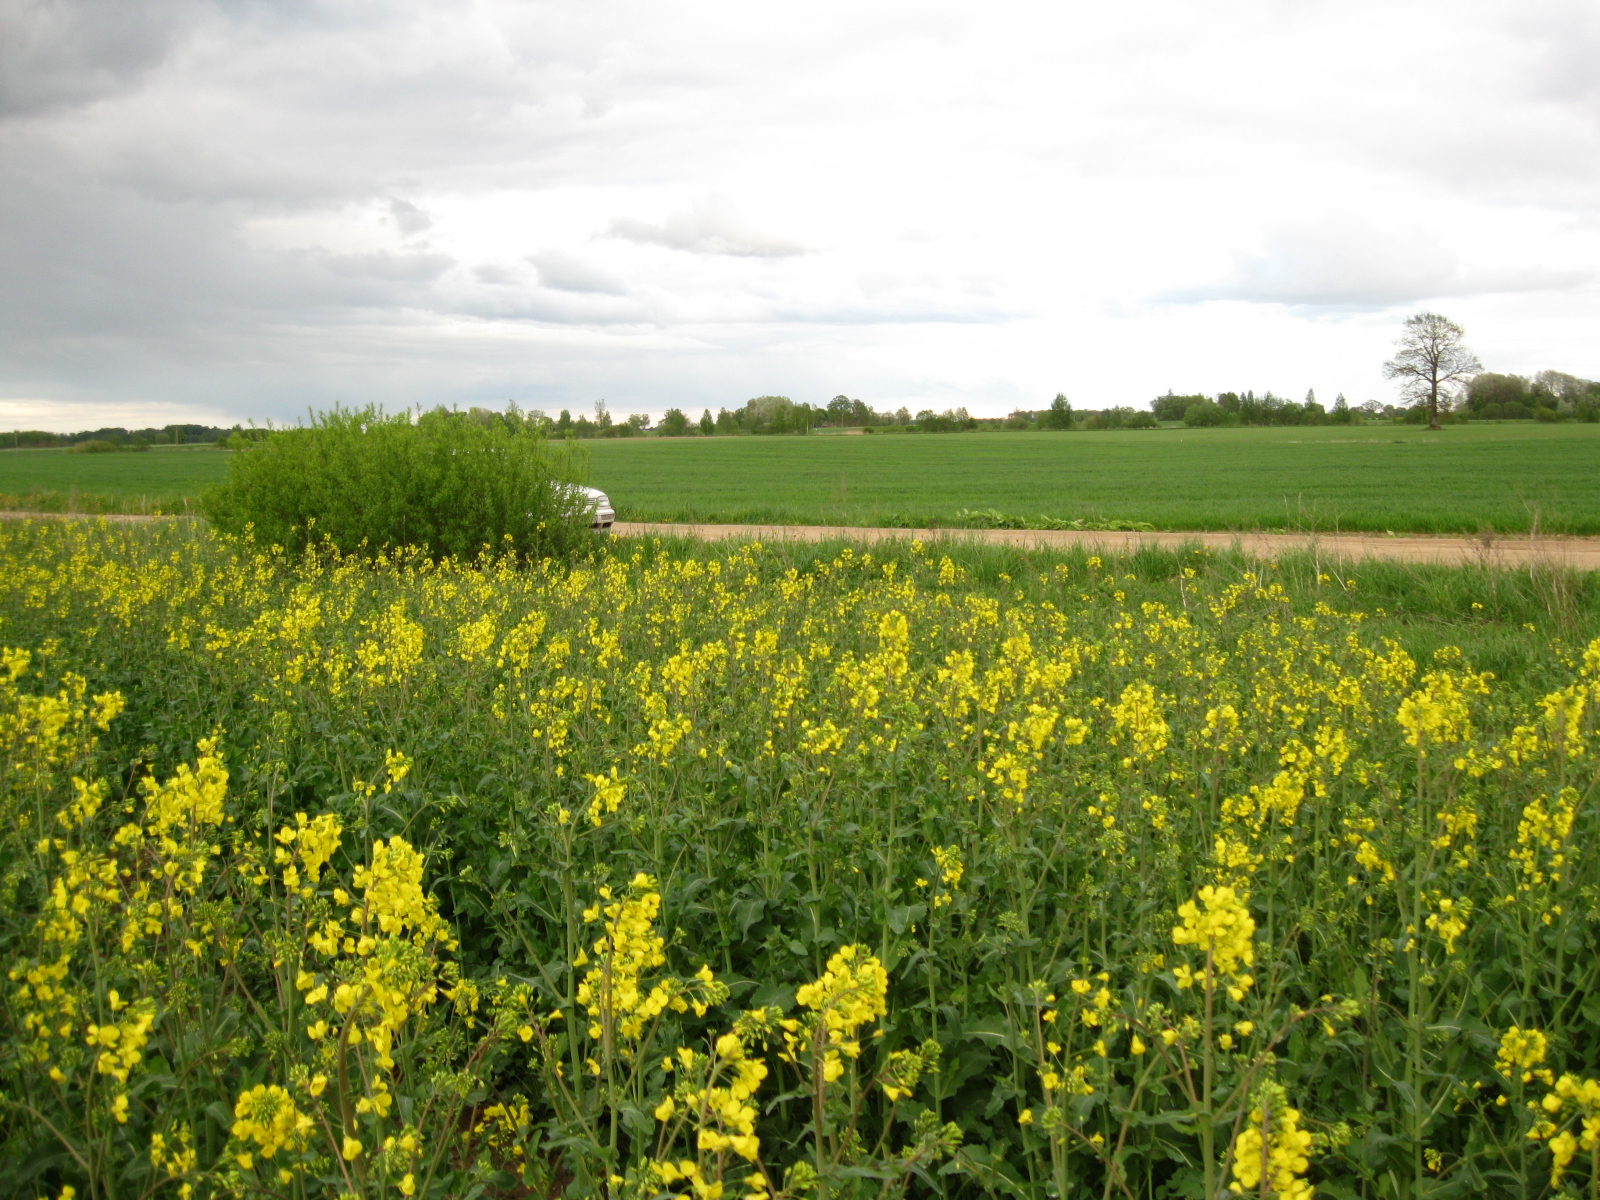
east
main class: Cropland
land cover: Rape and turnip rape
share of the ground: > 75 %
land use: Agriculture (excluding fallow land and kitchen gardens)
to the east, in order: Rape and turnip rape; Electric lines; Grassland without tree/shrub cover; Paved roads, cycling and walking lanes; Grass margins; Common wheat
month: May
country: LT
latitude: 56.2806
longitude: 23.4325
